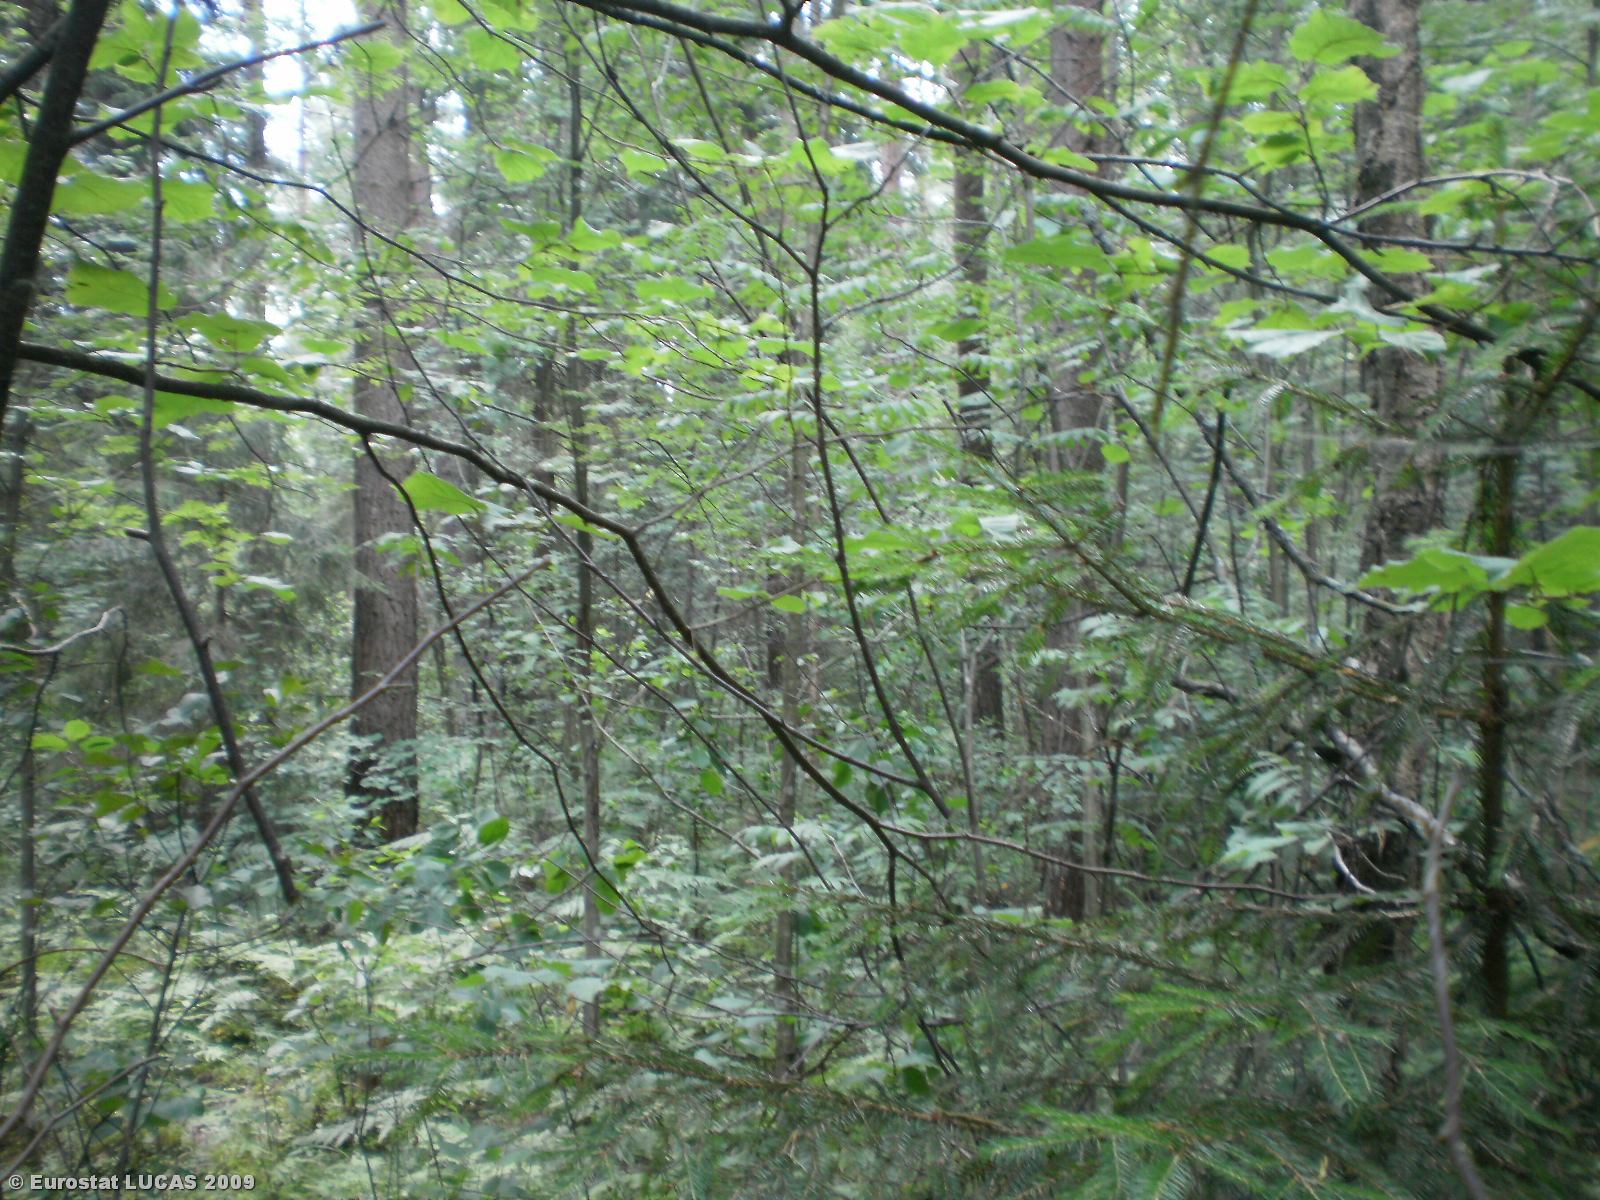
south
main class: Woodland
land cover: Coniferous woodland
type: boreal forest
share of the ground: 25 - 50 %
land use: Forestry
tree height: > 5 m
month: July
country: LT
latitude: 56.0110
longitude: 25.1750
